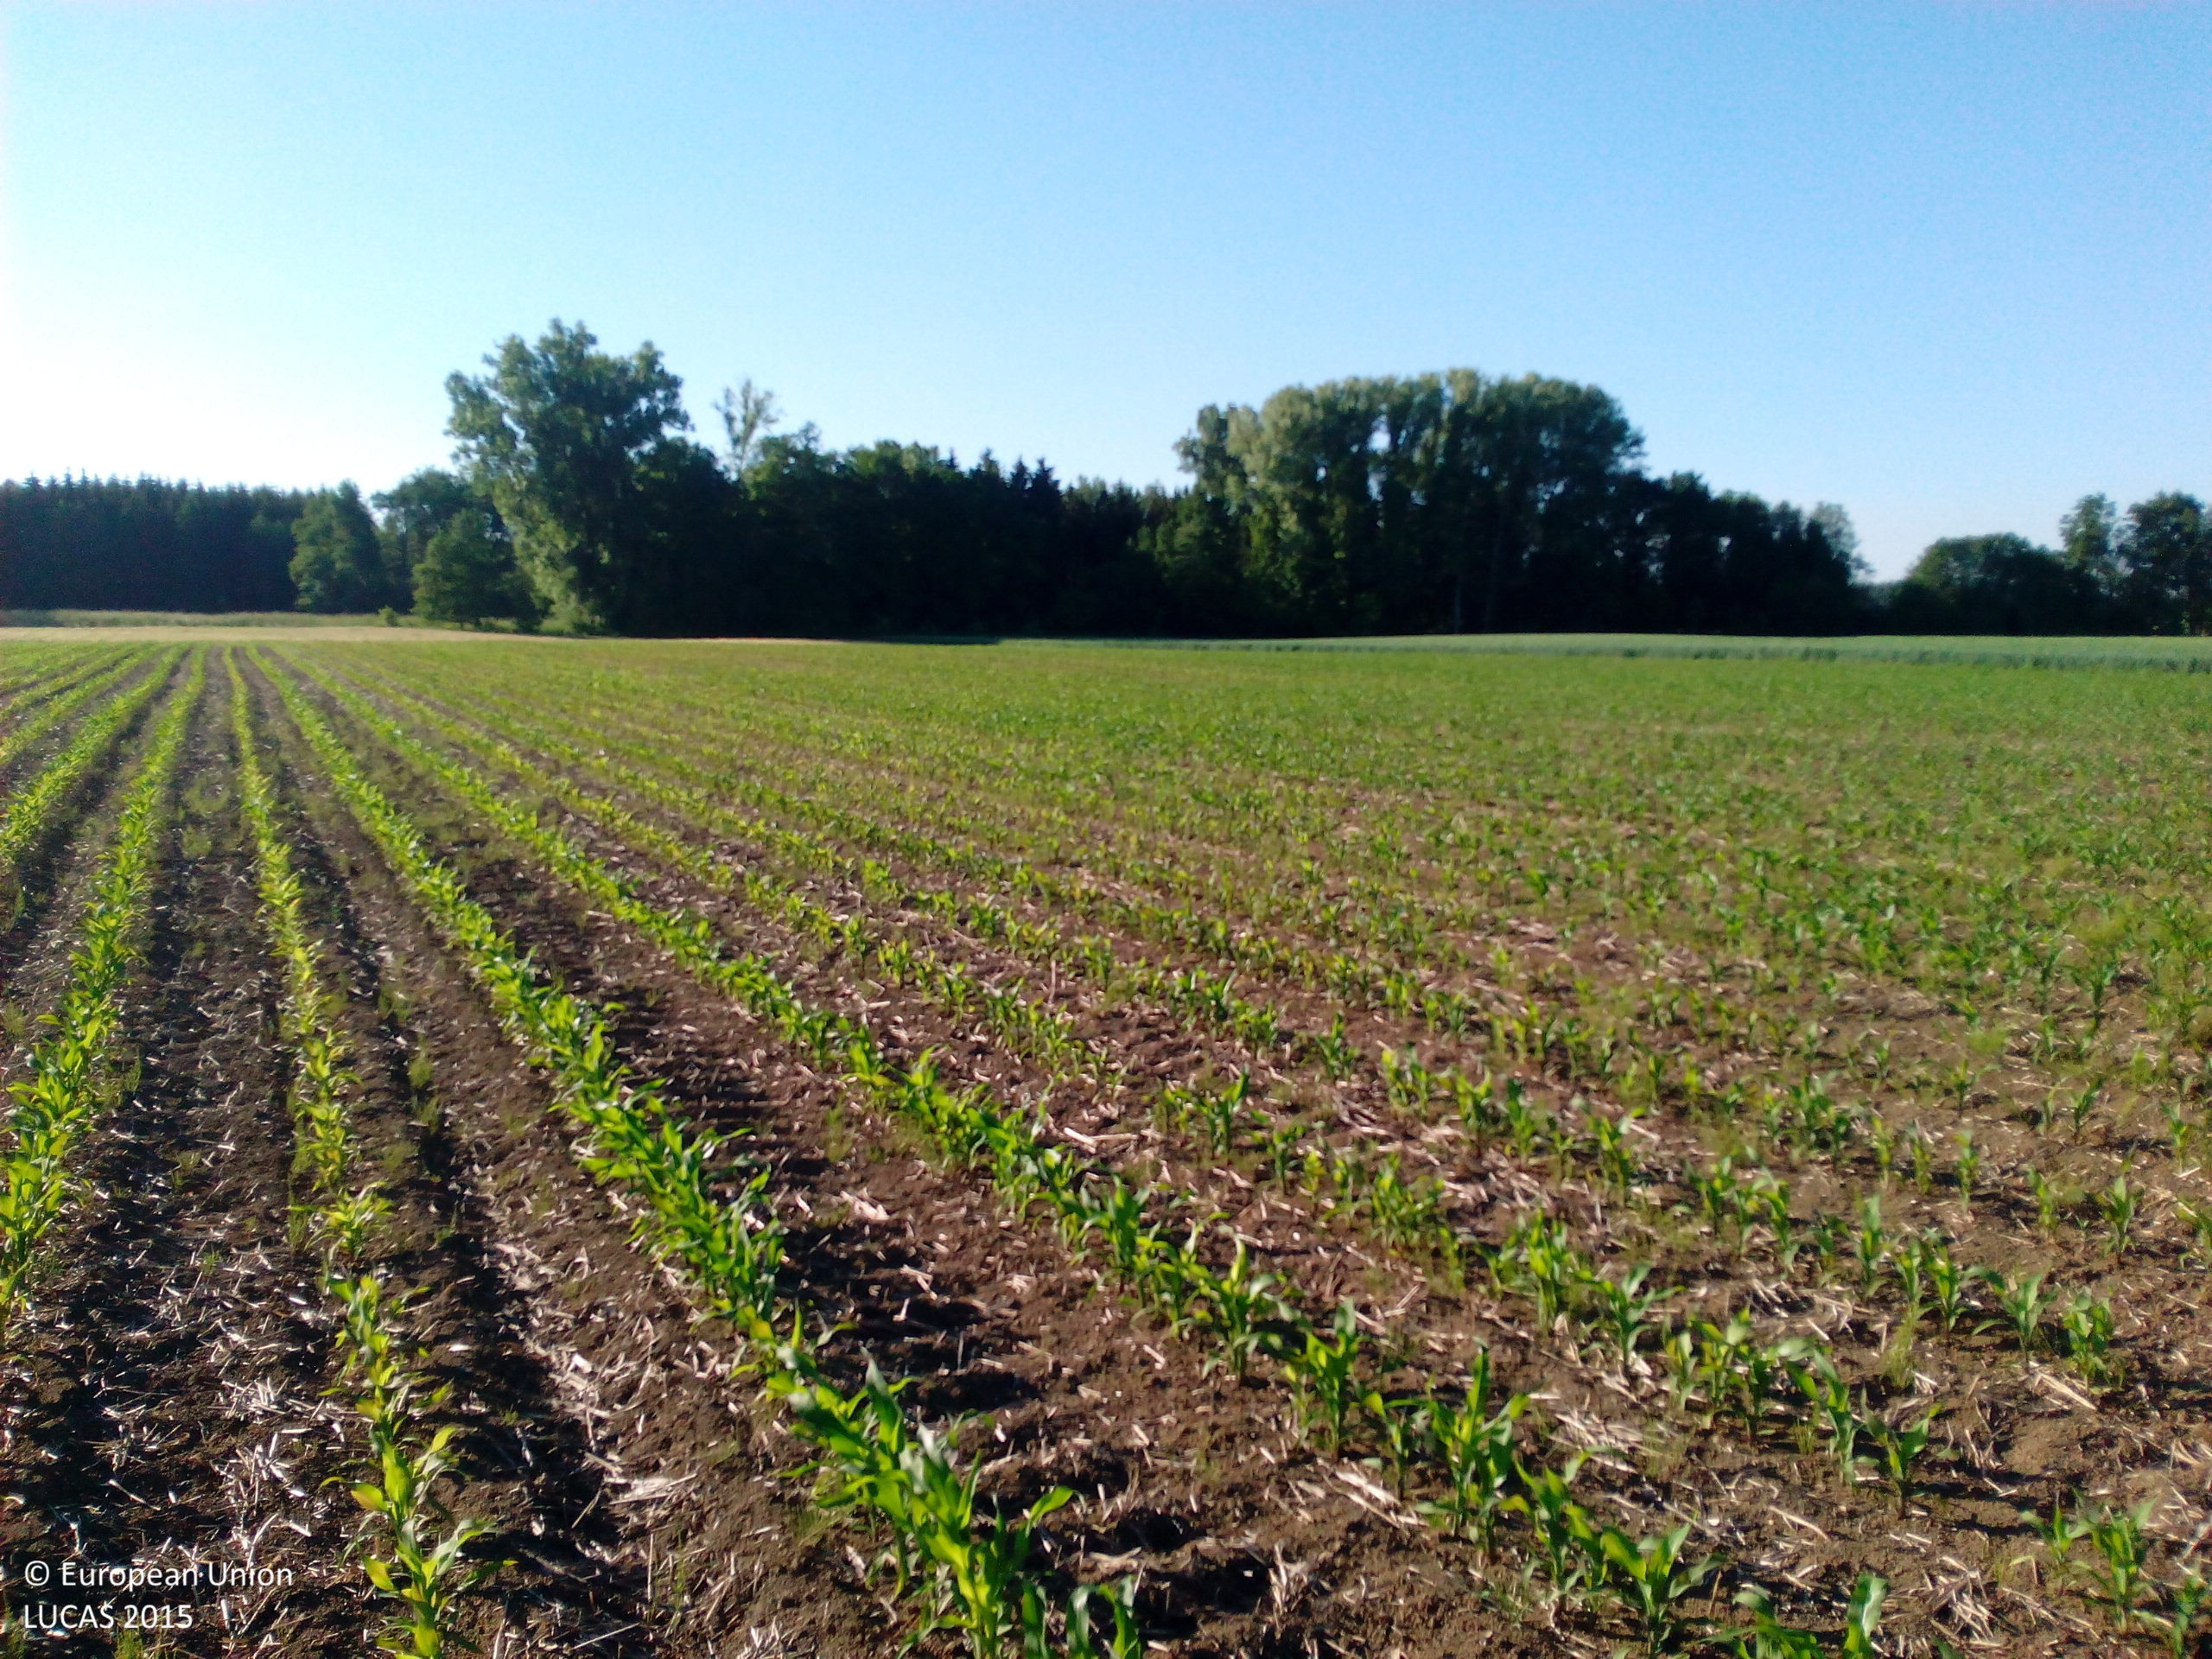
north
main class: Cropland
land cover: Maize
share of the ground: < 10 %
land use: Agriculture (excluding fallow land and kitchen gardens)
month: June
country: DE
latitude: 48.8452
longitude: 12.4112
